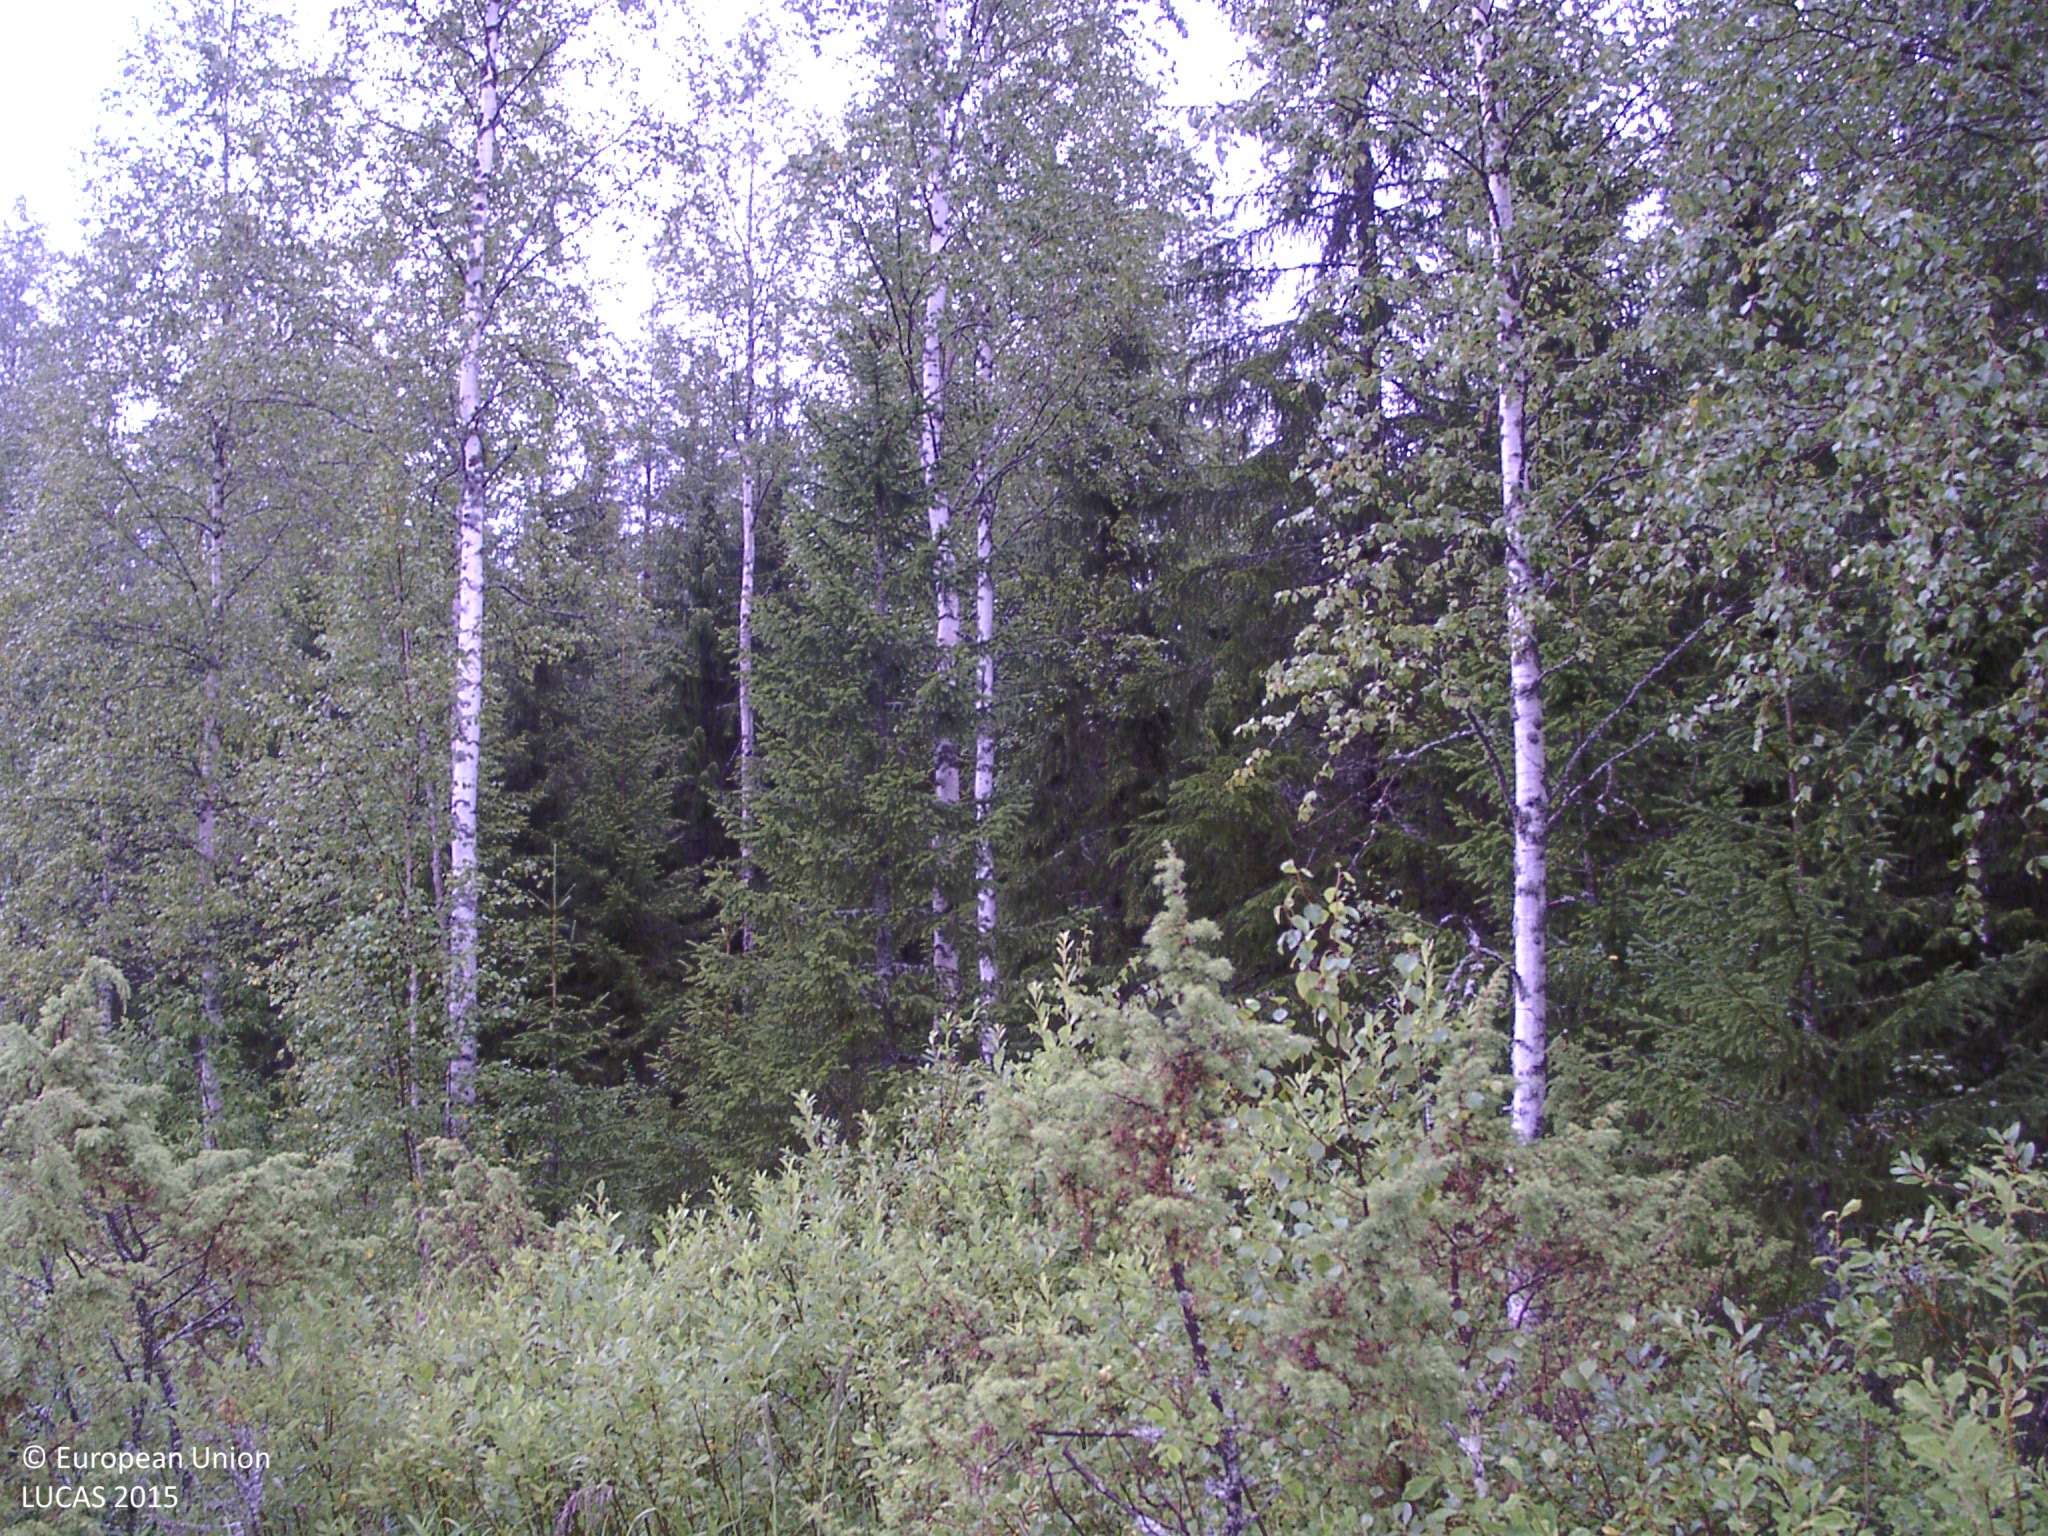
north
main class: Woodland
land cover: Broadleaved woodland
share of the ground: 25 - 50 %
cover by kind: shrubs 55 %, broadleaved forest trees 20 %, herbaceous plants 20 %, coniferous forest trees 5 %
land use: Logistics and storage
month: August
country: FI
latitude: 62.8415
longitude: 24.5203
